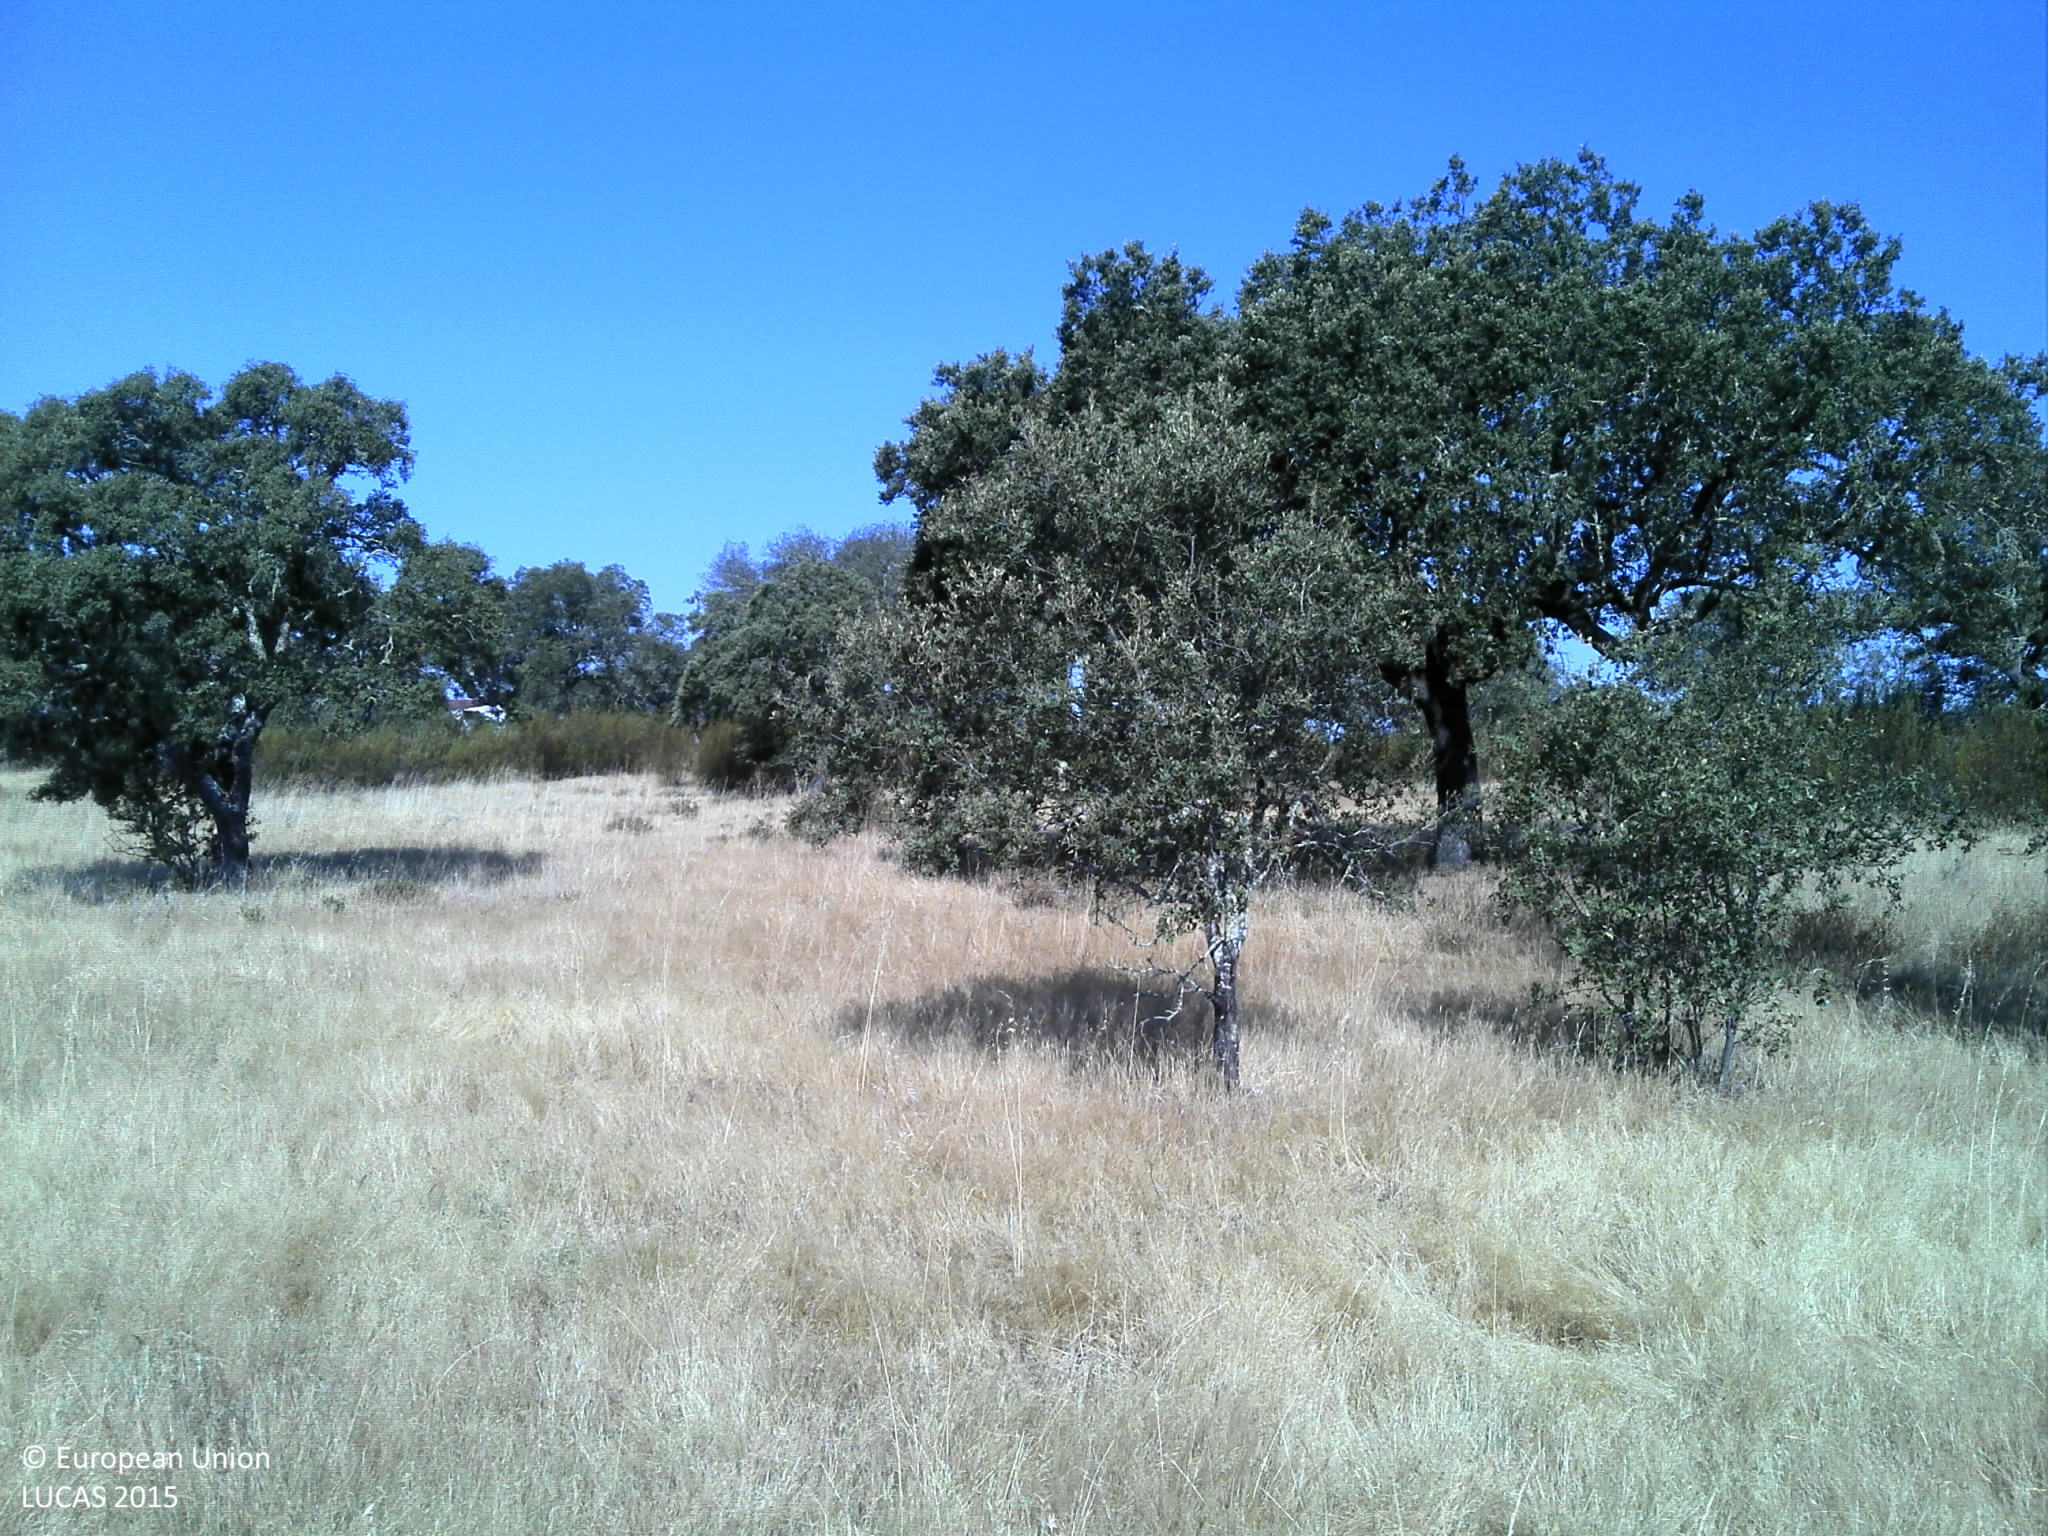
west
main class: Woodland
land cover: Broadleaved woodland
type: broadleaved evergreen forest
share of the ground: 10 - 25 %
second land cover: Grassland without tree/shrub cover
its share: 50 - 75 %
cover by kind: herbaceous plants 75 %, unconsolidated bare surface 15 %, broadleaved forest trees 10 %
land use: Forestry
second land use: Agriculture (excluding fallow land and kitchen gardens)
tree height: > 5 m
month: June
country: PT
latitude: 38.3161
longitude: -7.7706
